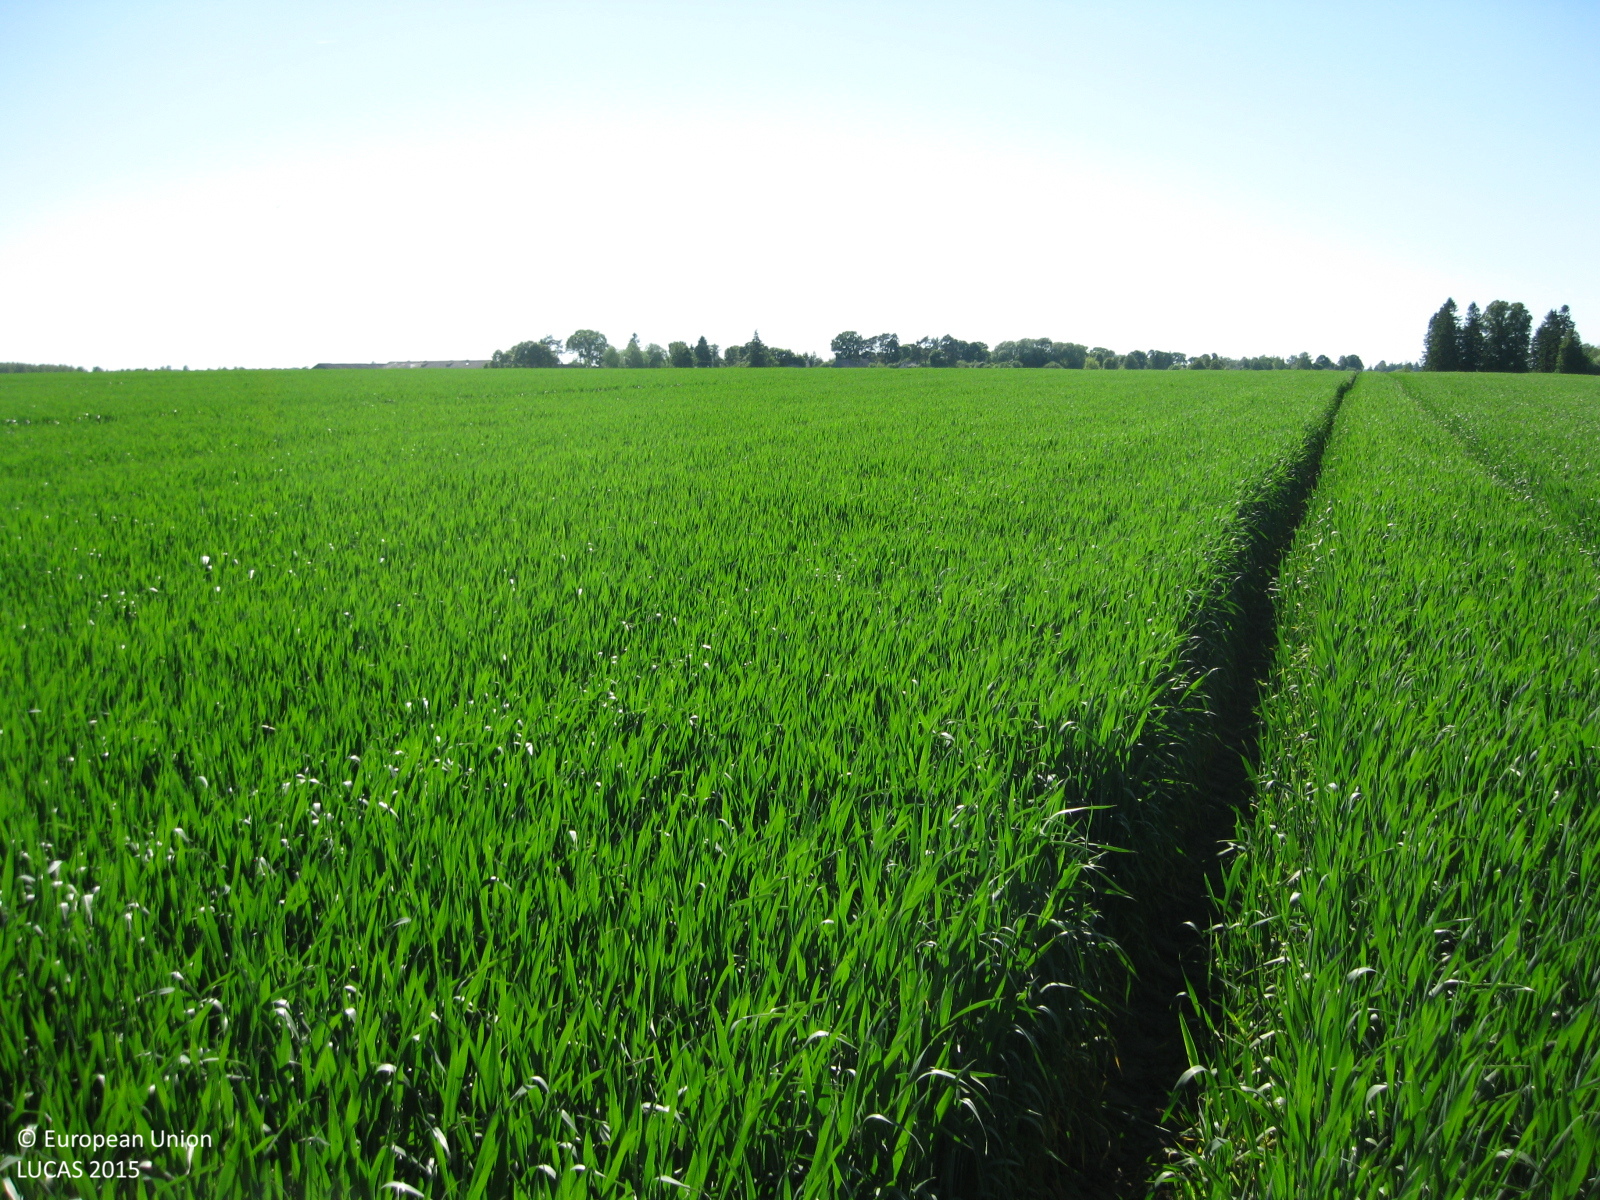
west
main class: Cropland
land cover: Common wheat
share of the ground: > 75 %
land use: Agriculture (excluding fallow land and kitchen gardens)
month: June
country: LT
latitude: 55.7025
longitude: 24.0447
